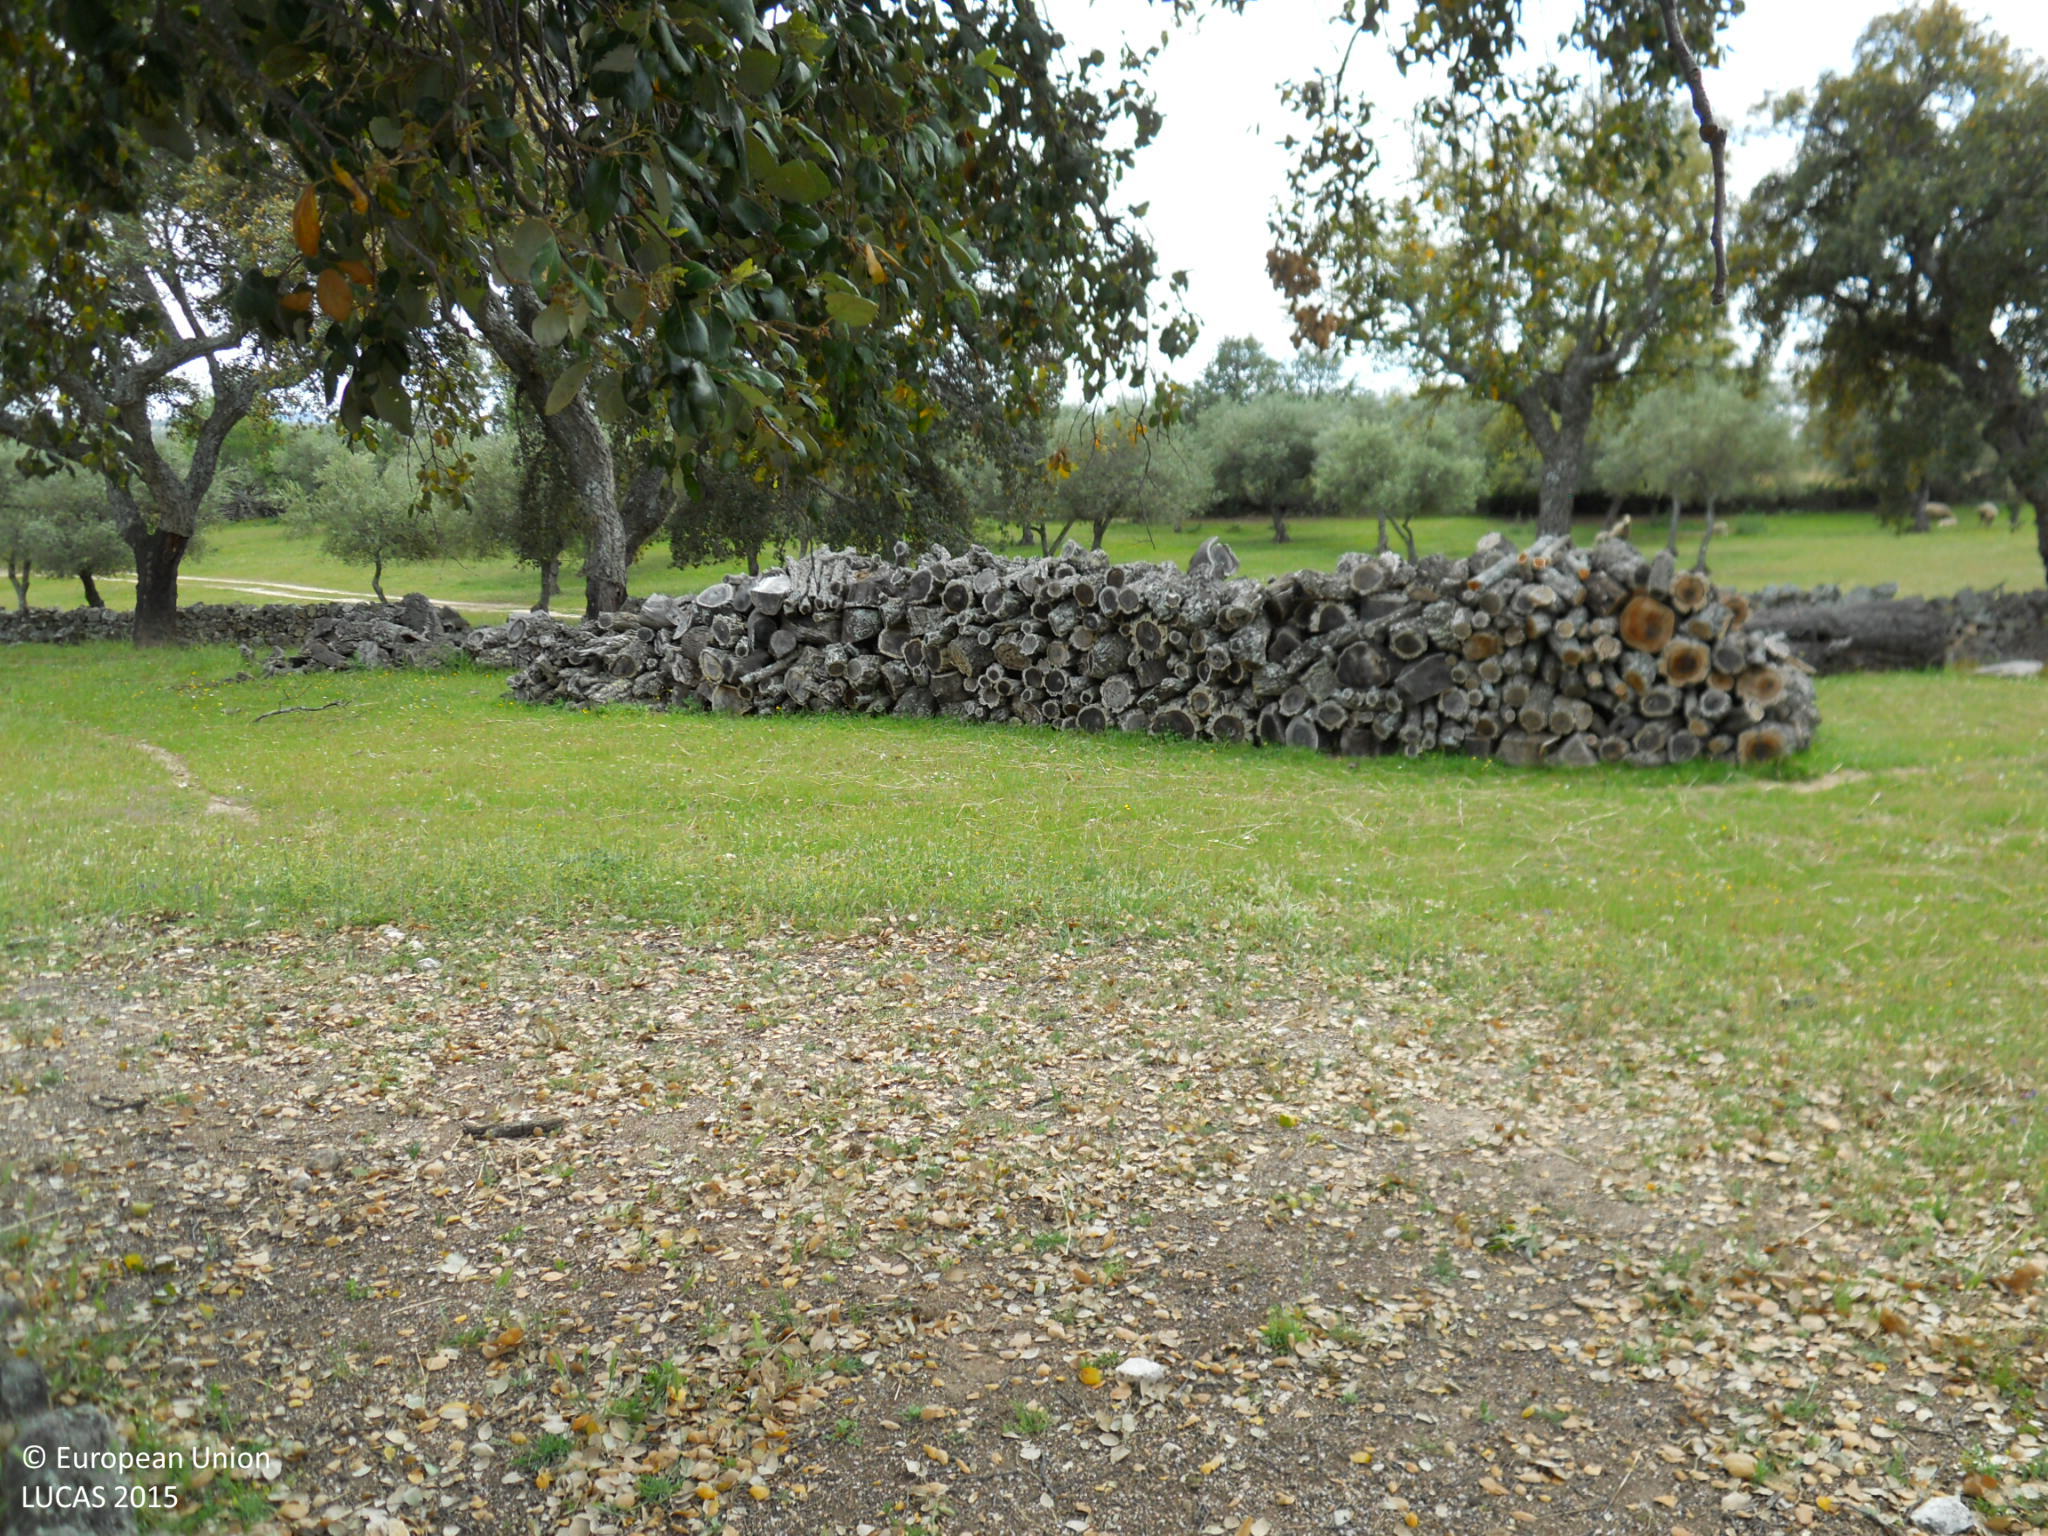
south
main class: Woodland
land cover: Broadleaved woodland
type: broadleaved evergreen forest
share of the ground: 25 - 50 %
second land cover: Grassland without tree/shrub cover
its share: > 75 %
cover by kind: herbaceous plants 80 %, broadleaved forest trees 15 %, shrubs 5 %
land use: Forestry
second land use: Agriculture (excluding fallow land and kitchen gardens)
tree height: > 5 m
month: April
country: ES
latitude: 39.3216
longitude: -7.1207
